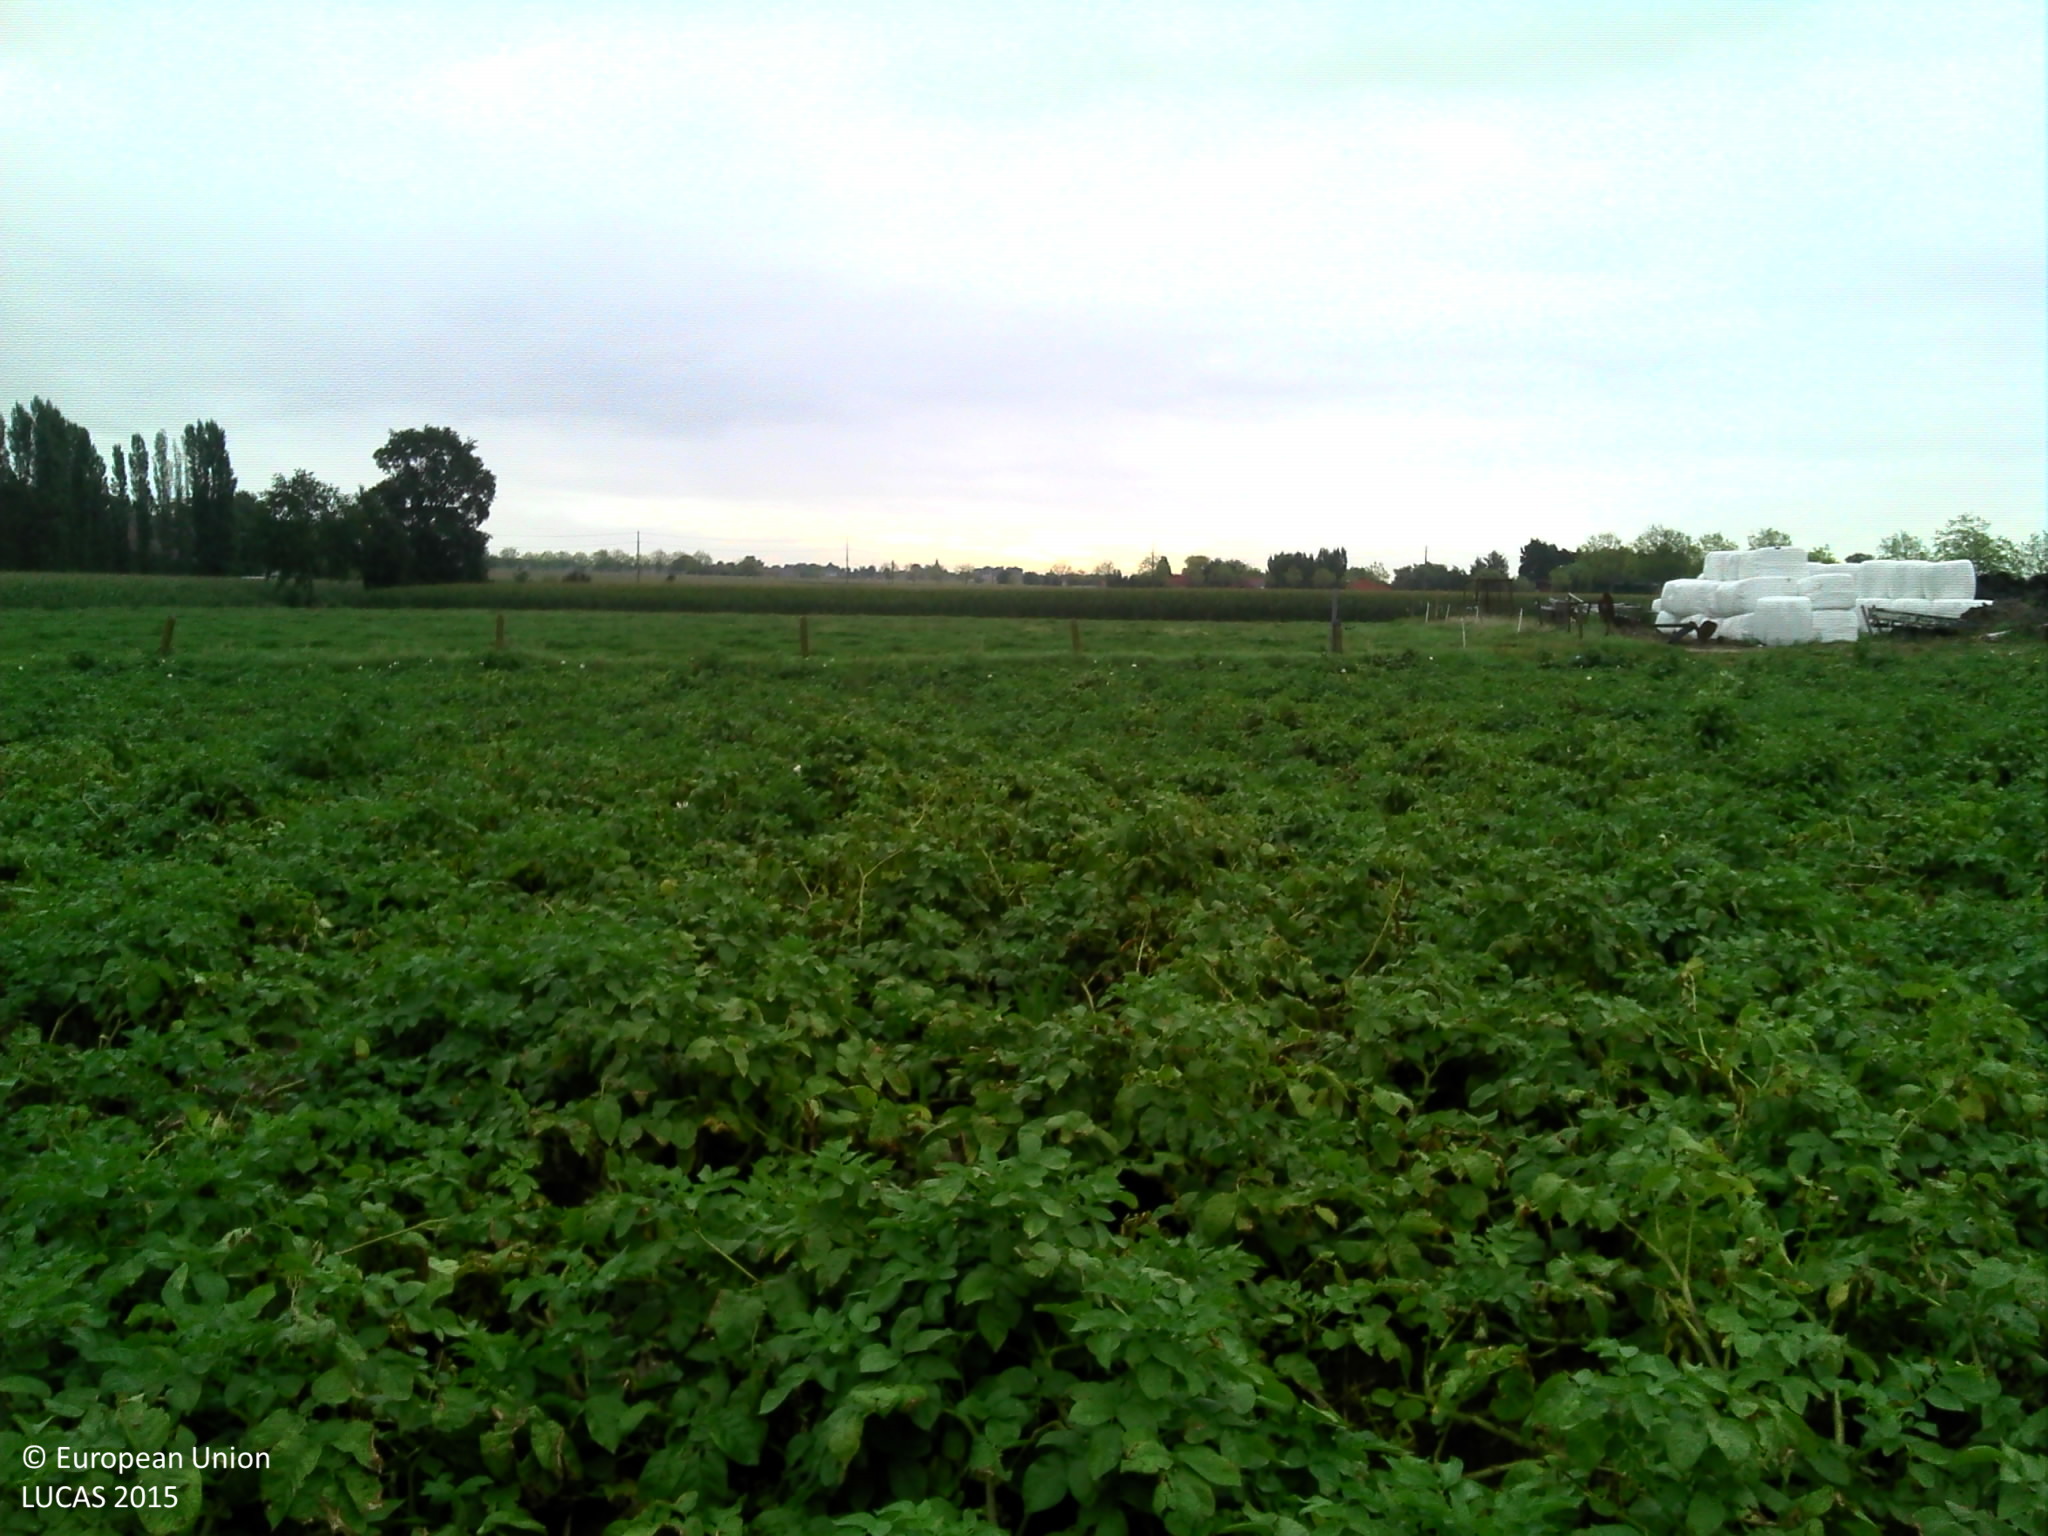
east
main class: Cropland
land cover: Potatoes
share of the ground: > 75 %
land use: Agriculture (excluding fallow land and kitchen gardens)
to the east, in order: Potatoes; Fences; Grassland without tree/shrub cover; Fences; Maize
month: September
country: BE
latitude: 51.0062
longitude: 3.4505
